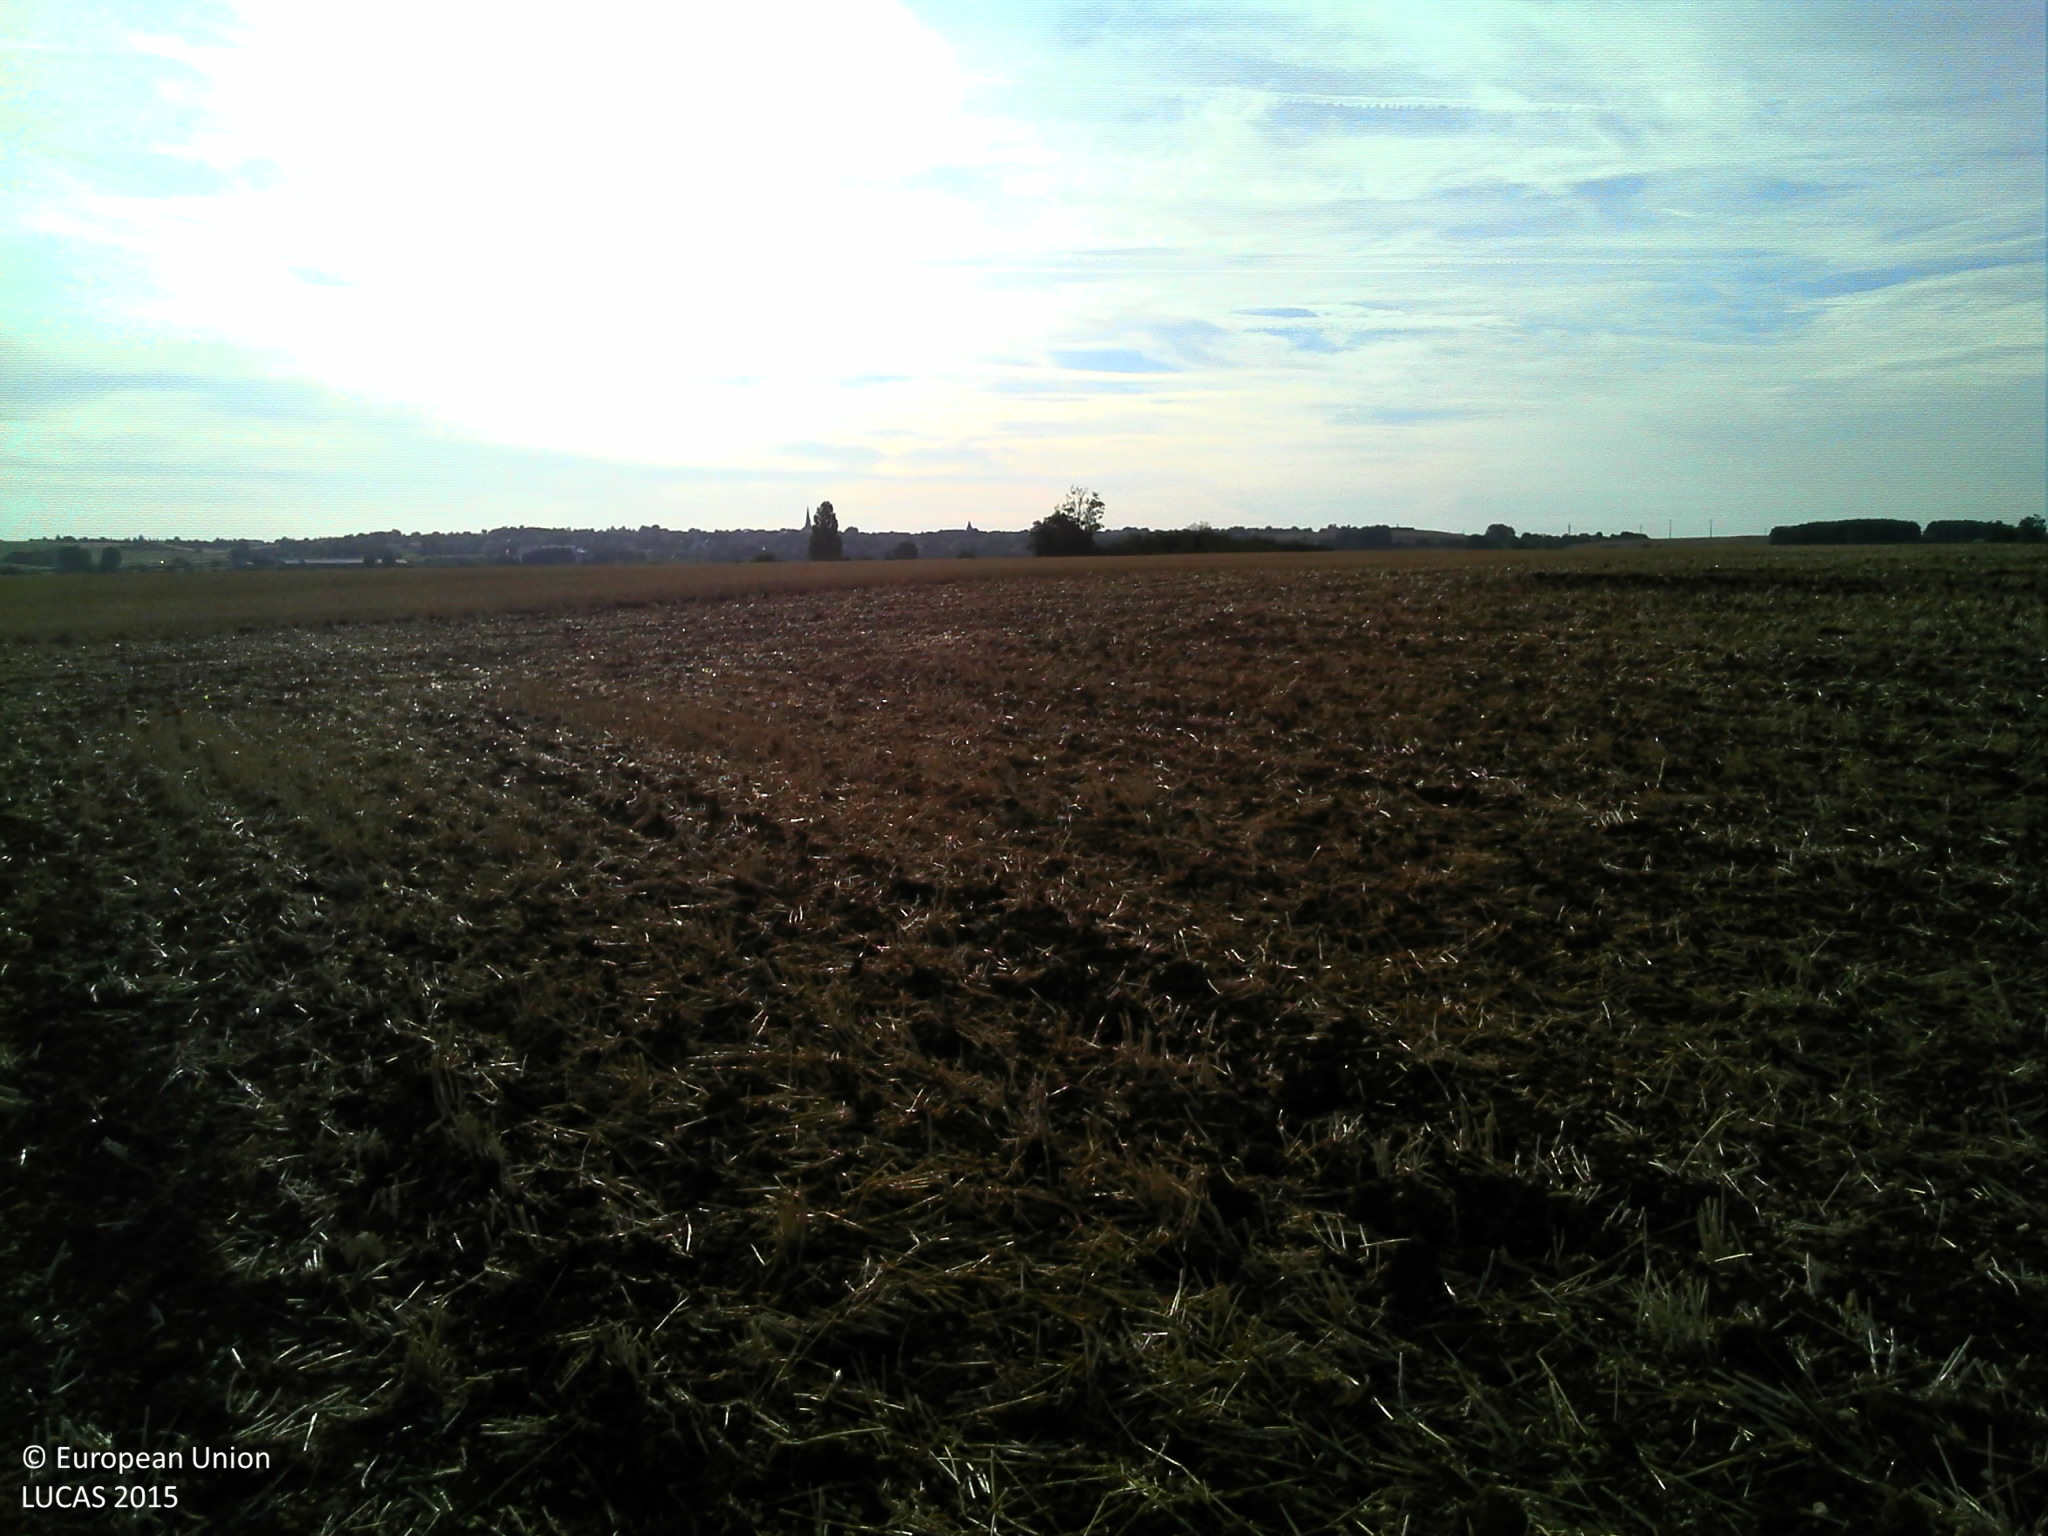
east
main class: Cropland
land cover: Common wheat
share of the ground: 10 - 25 %
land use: Agriculture (excluding fallow land and kitchen gardens)
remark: Tilled/Sowed
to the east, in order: Common wheat
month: July
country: FR
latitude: 46.7835
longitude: 0.1414
